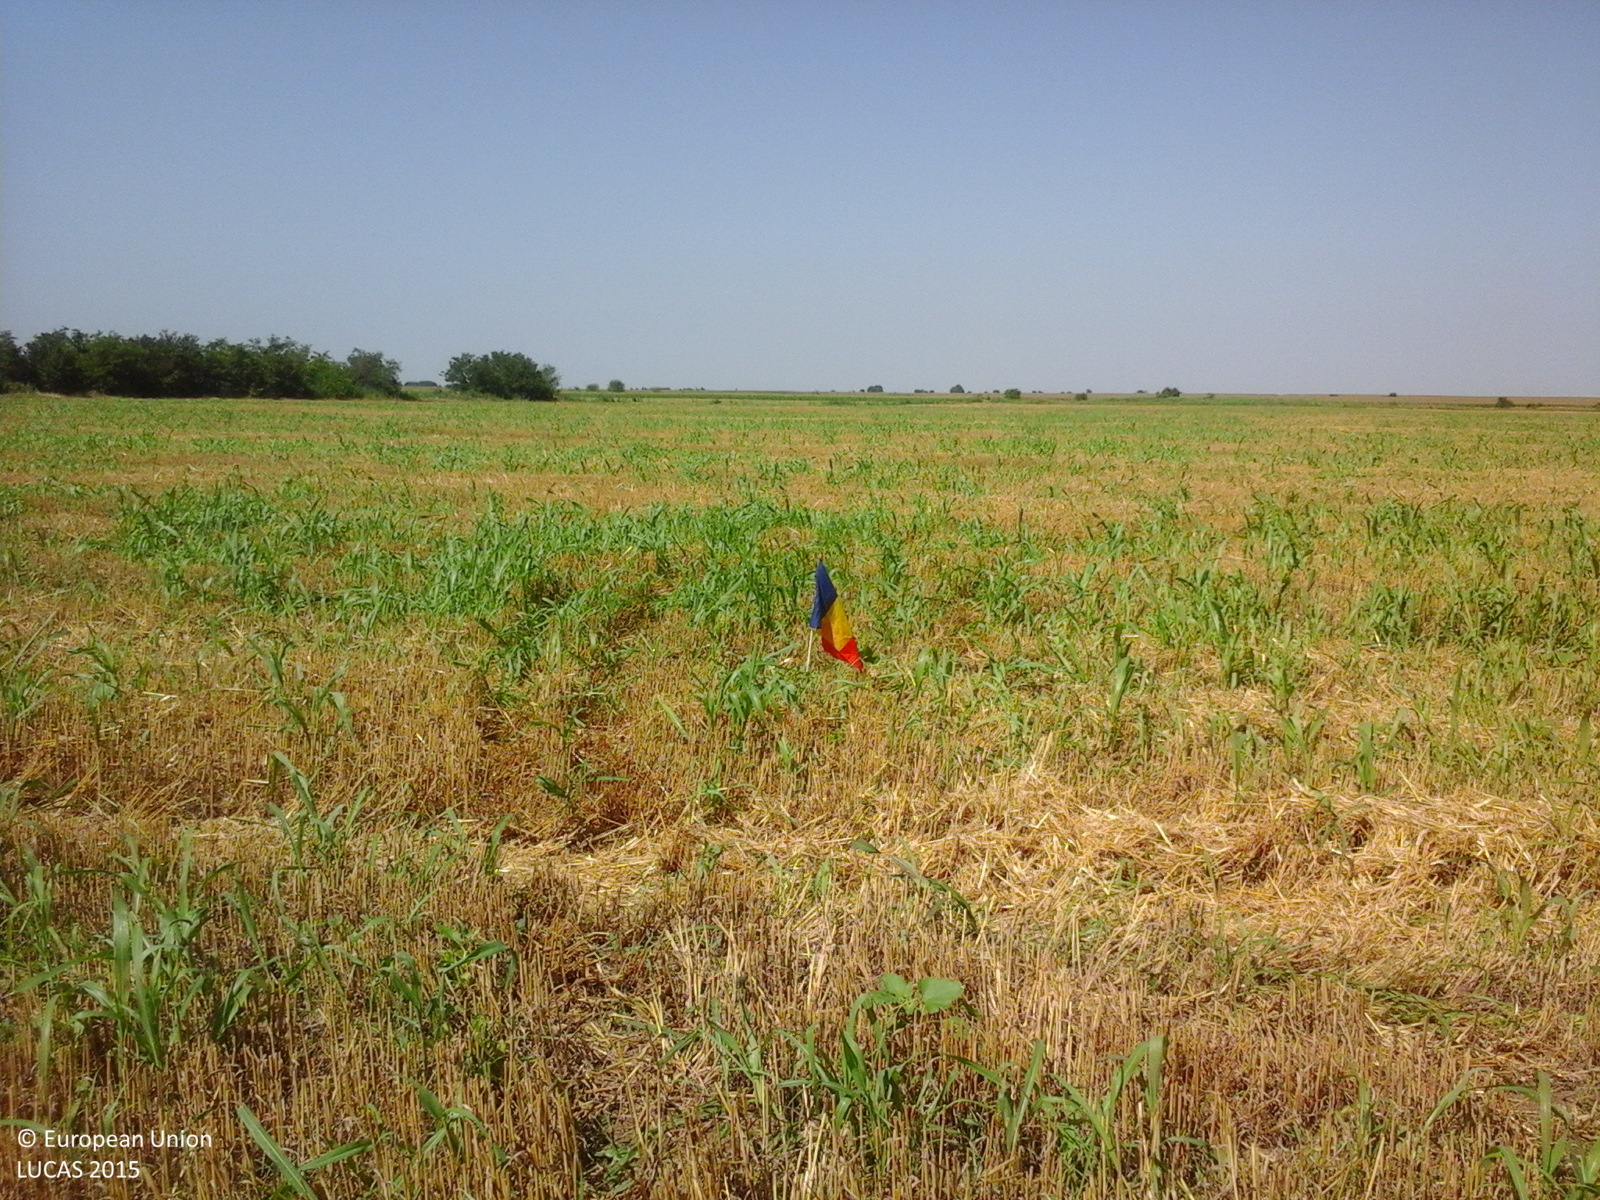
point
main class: Cropland
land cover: Durum wheat
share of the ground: 50 - 75 %
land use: Agriculture (excluding fallow land and kitchen gardens)
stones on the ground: < 10 %
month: July
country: RO
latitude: 44.4890
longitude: 27.1721
